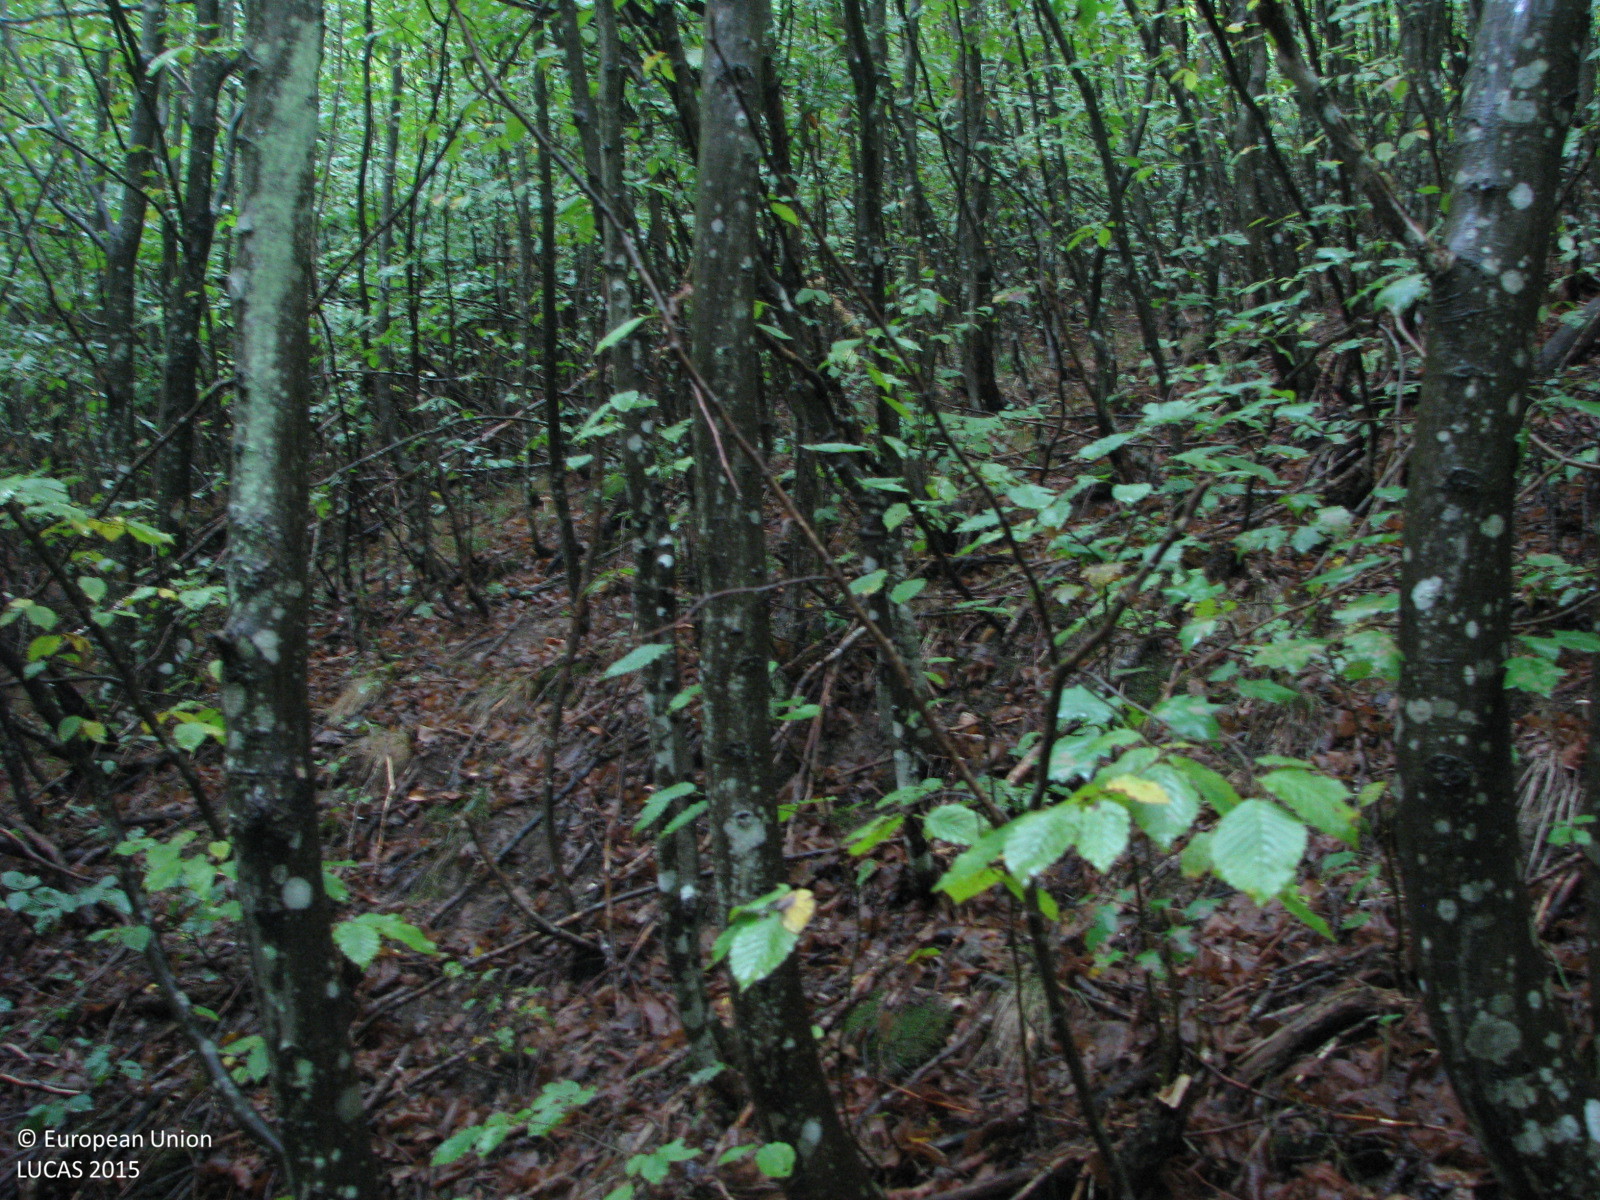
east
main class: Woodland
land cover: Broadleaved woodland
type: mesophytic deciduous forest
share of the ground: > 75 %
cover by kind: broadleaved forest trees 100 %
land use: Forestry
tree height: > 5 m
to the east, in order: Broadleaved woodland; Rivers and streams; Broadleaved woodland; Rivers and streams; Broadleaved woodland
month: September
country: BG
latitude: 42.9282
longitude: 26.3784
